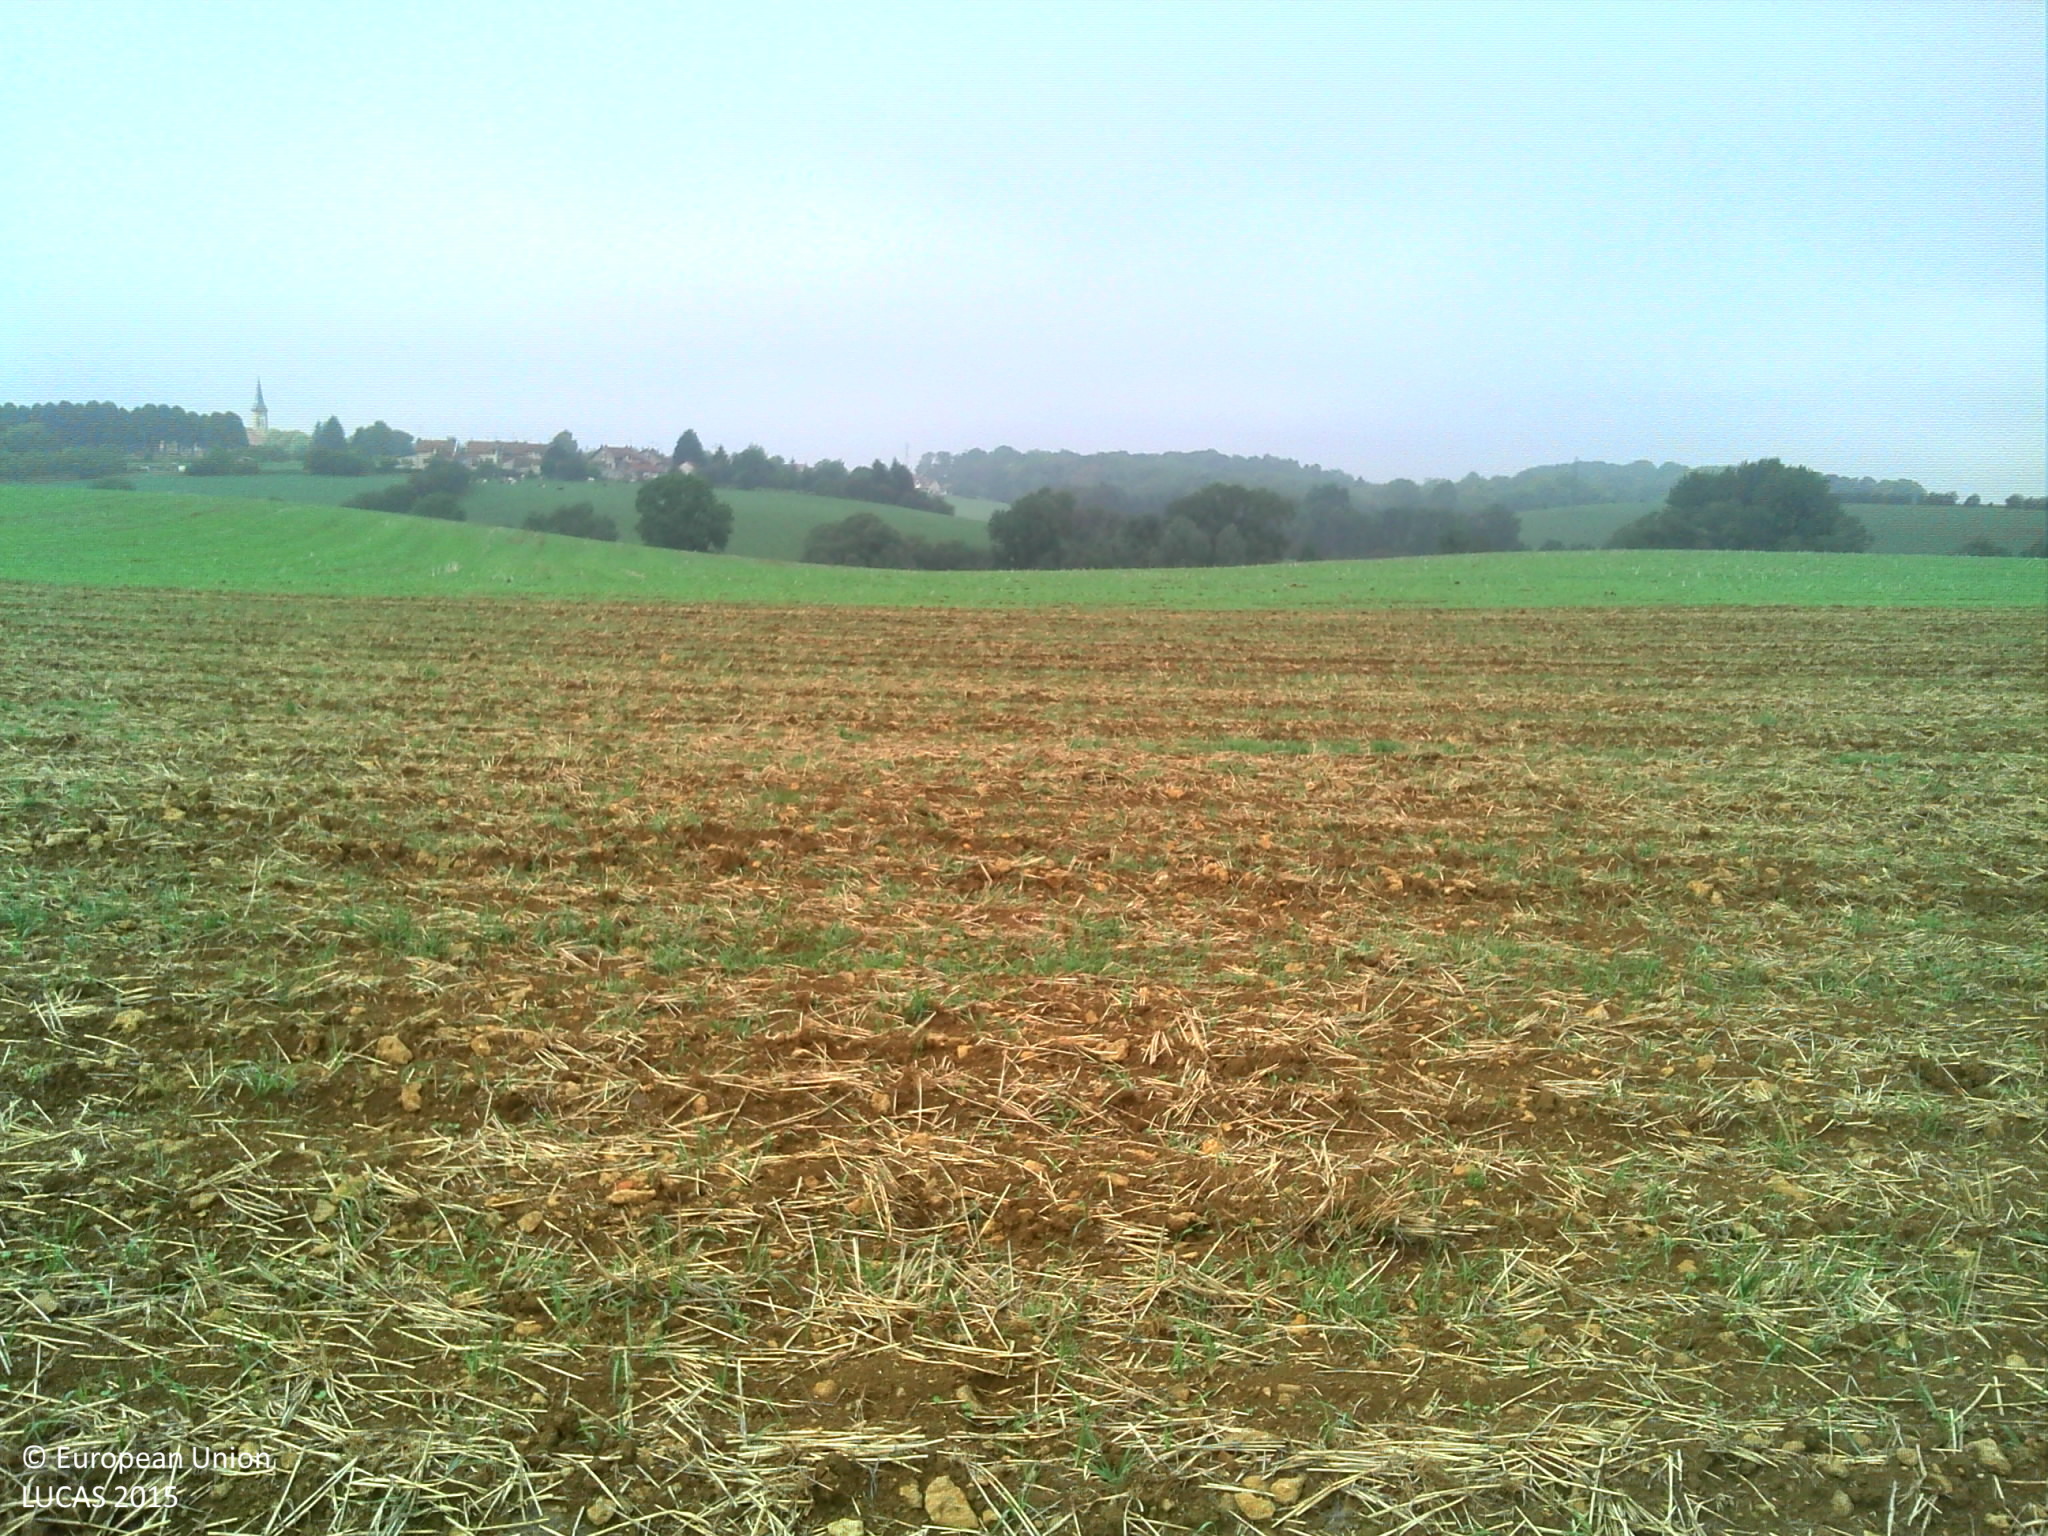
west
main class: Cropland
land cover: Other fibre and oleaginous crops
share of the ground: < 10 %
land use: Agriculture (excluding fallow land and kitchen gardens)
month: September
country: FR
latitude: 49.1751
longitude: 5.9254
